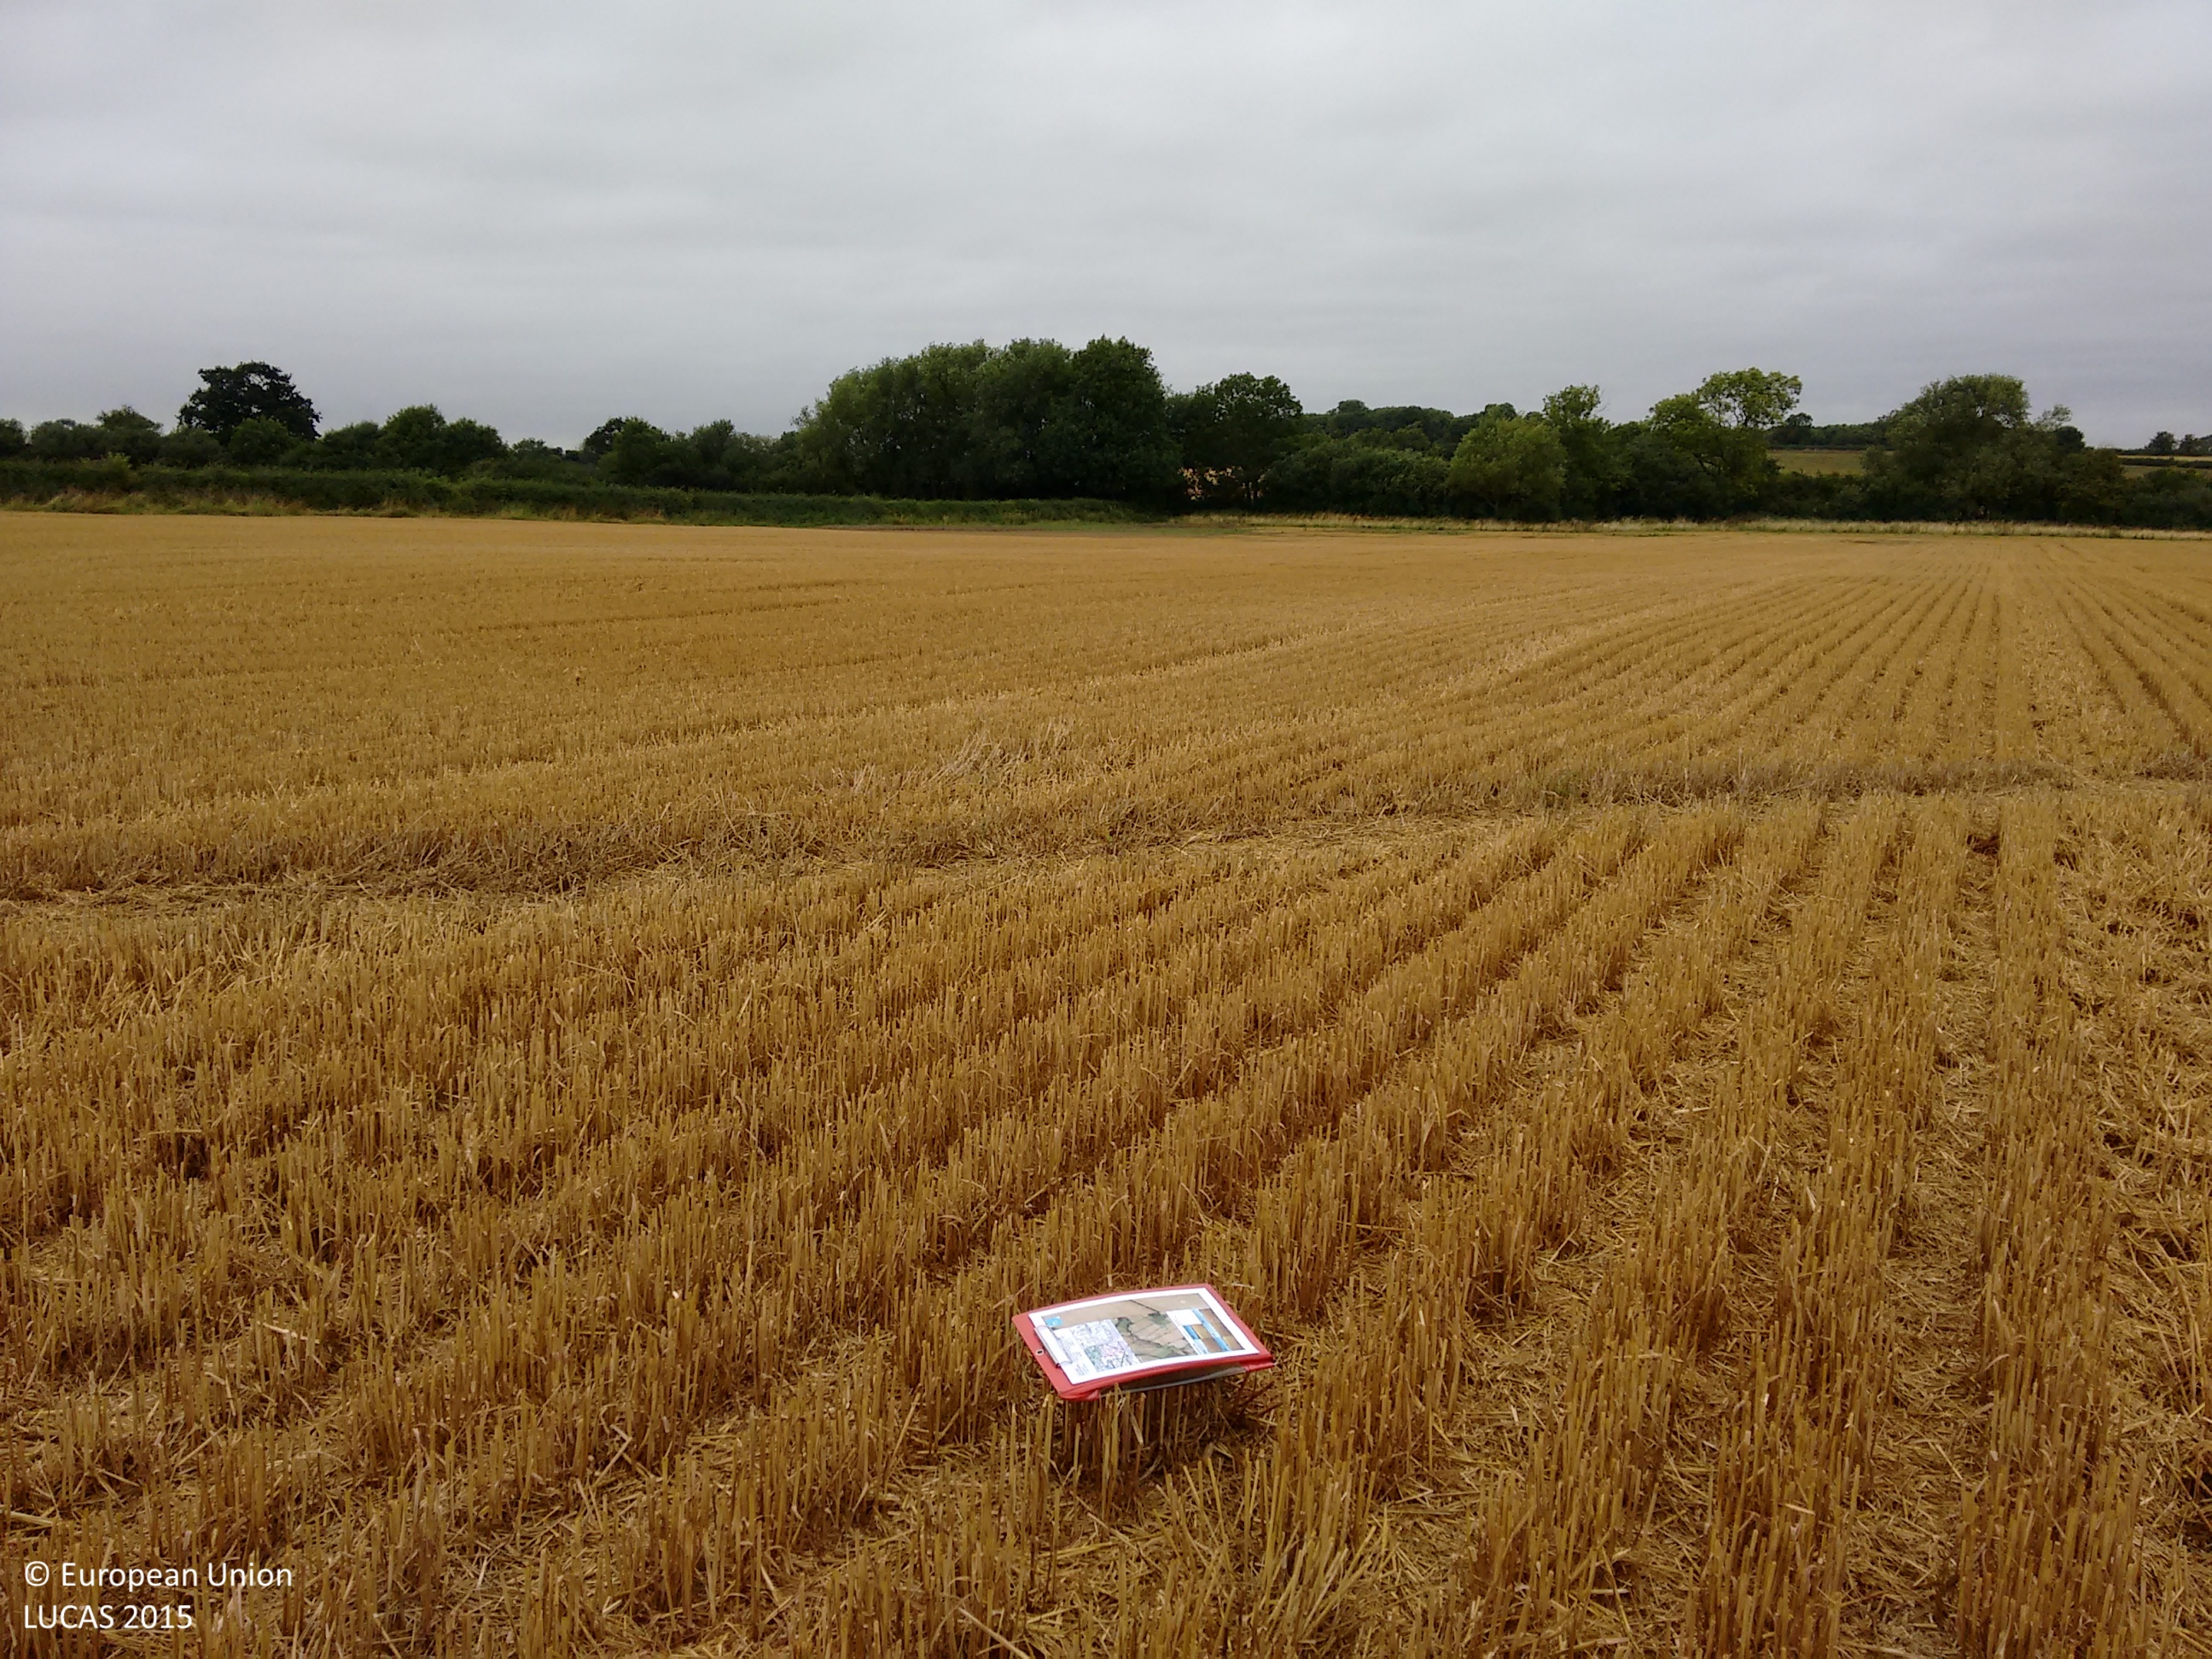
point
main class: Cropland
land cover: Common wheat
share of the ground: > 75 %
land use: Agriculture (excluding fallow land and kitchen gardens)
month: August
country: GB
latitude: 52.6068
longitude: -1.4051
